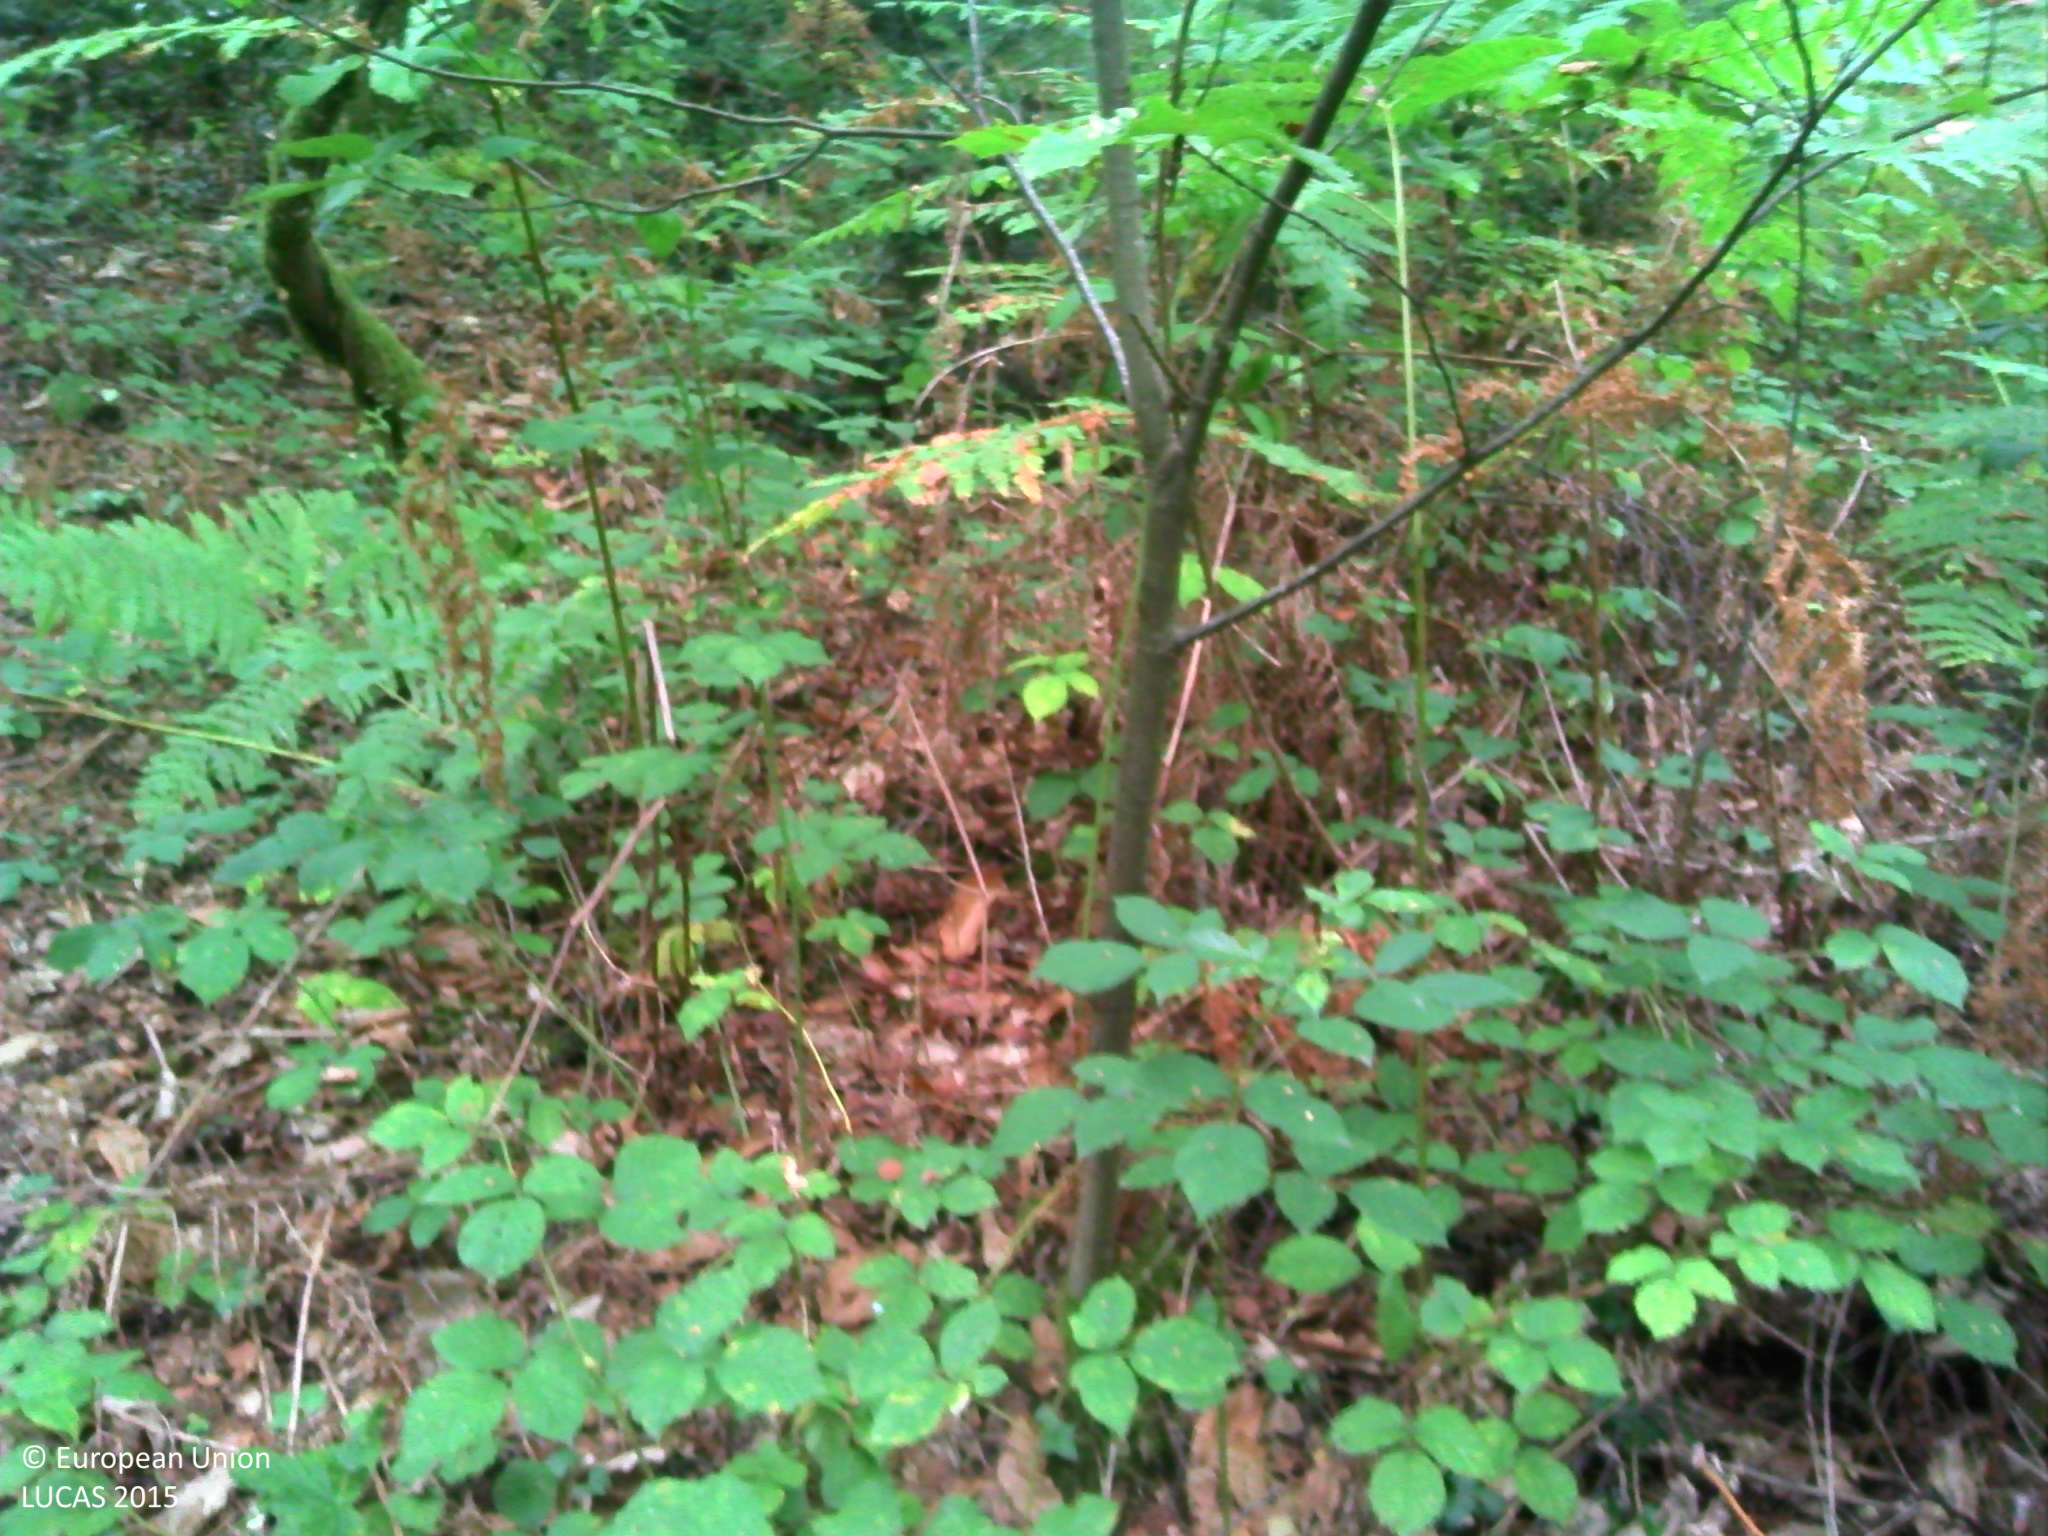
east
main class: Woodland
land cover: Broadleaved woodland
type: mesophytic deciduous forest
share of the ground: > 75 %
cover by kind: broadleaved forest trees 85 %, herbaceous plants 15 %
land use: Forestry
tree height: > 5 m
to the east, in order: Broadleaved woodland; Spontaneously vegetated surfaces; Broadleaved woodland
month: August
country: FR
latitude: 46.0404
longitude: 1.3978
